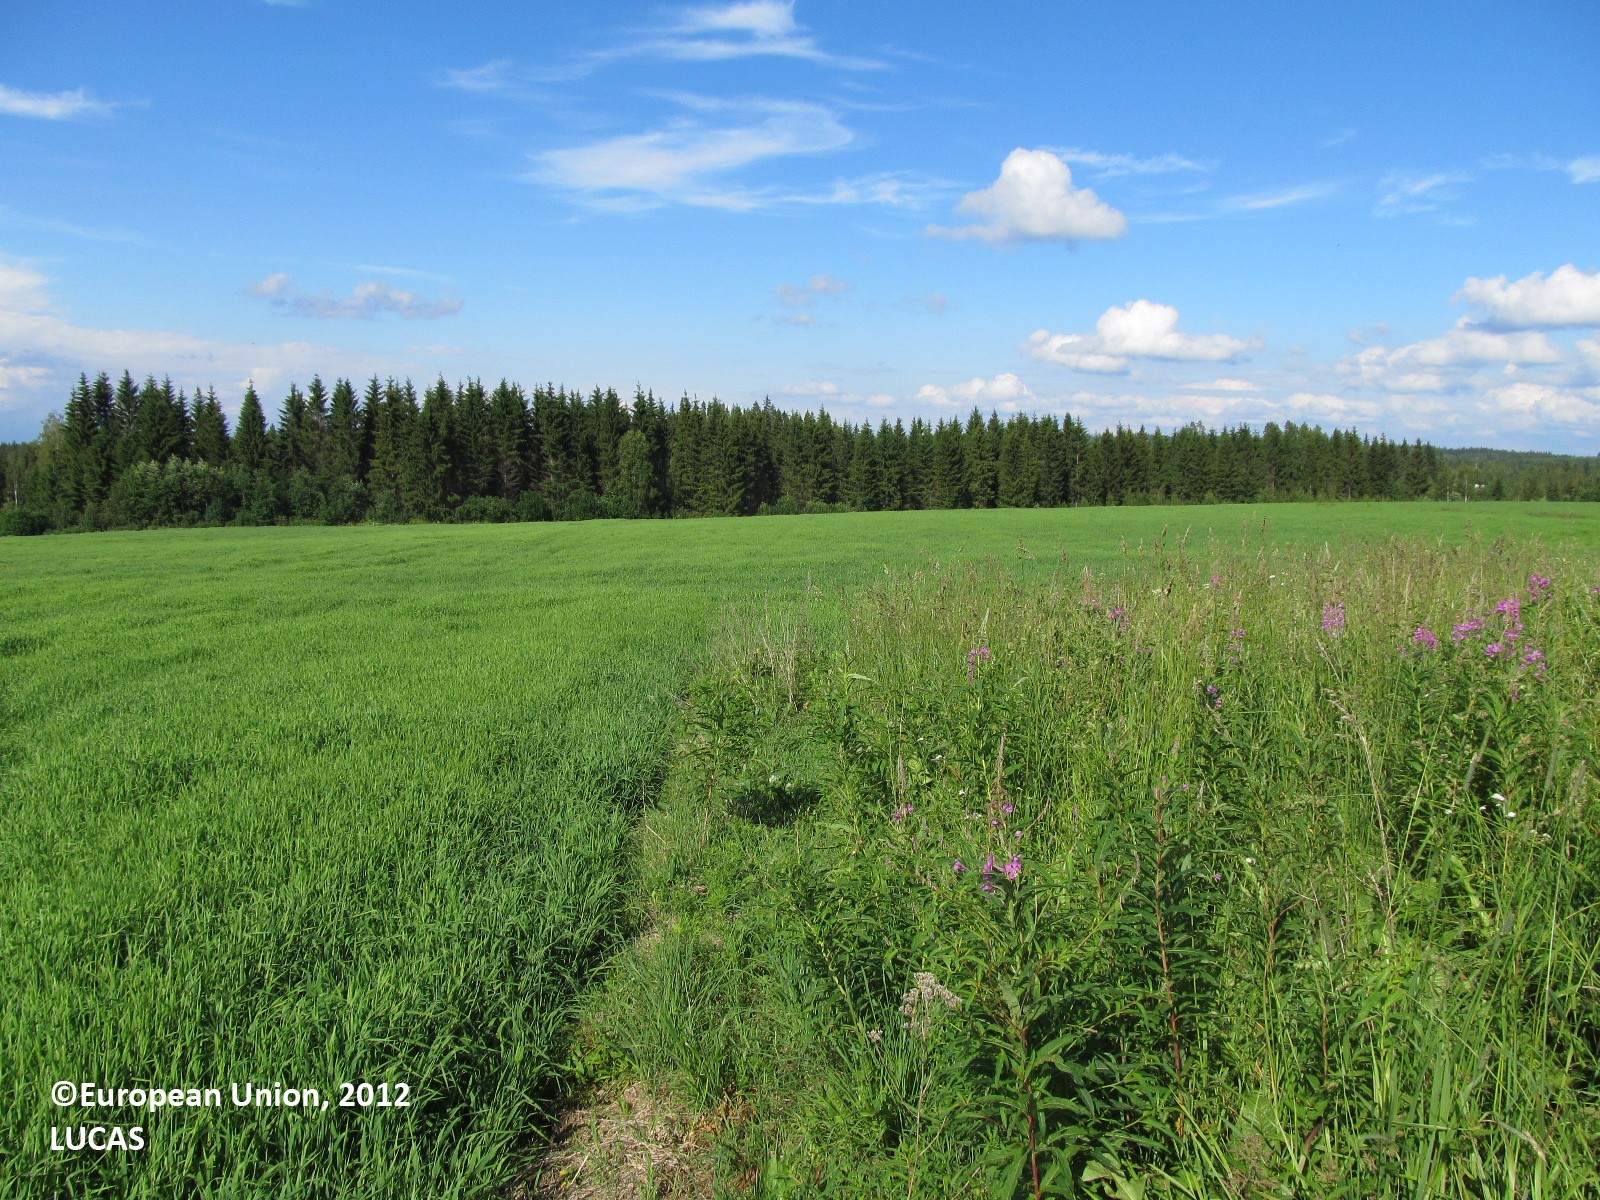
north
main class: Cropland
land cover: Barley
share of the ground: 50 - 75 %
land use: Agriculture (excluding fallow land and kitchen gardens)
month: July
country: FI
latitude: 61.9576
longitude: 28.4528
